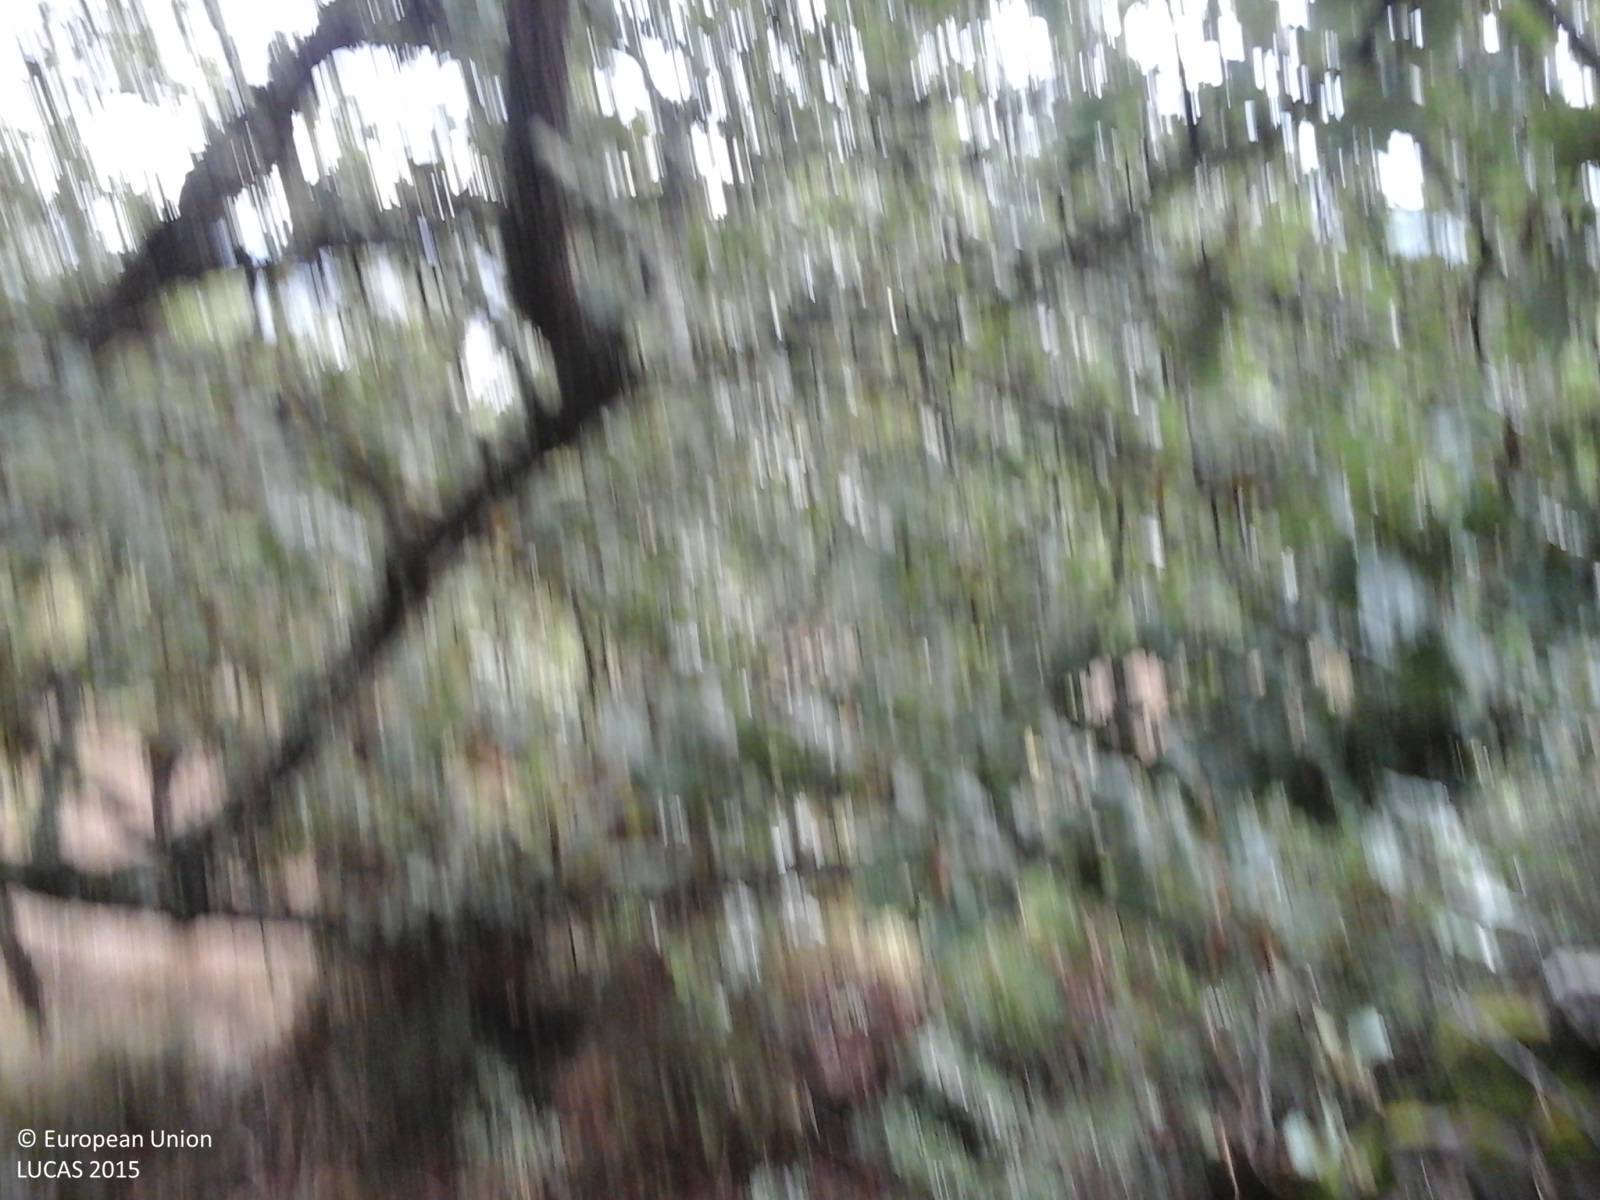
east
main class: Woodland
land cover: Broadleaved woodland
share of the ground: > 75 %
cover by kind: broadleaved forest trees 50 %, herbaceous plants 35 %, shrubs 15 %
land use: Agriculture (excluding fallow land and kitchen gardens)
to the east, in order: Broadleaved woodland; Fences; Abandoned hedges; Paved roads, cycling and walking lanes; Lines of trees; Grassland with sparse tree/shrub cover; Broadleaved woodland; Tracks; Grassland without tree/shrub cover
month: October
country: IT
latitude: 40.0979
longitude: 8.8683
